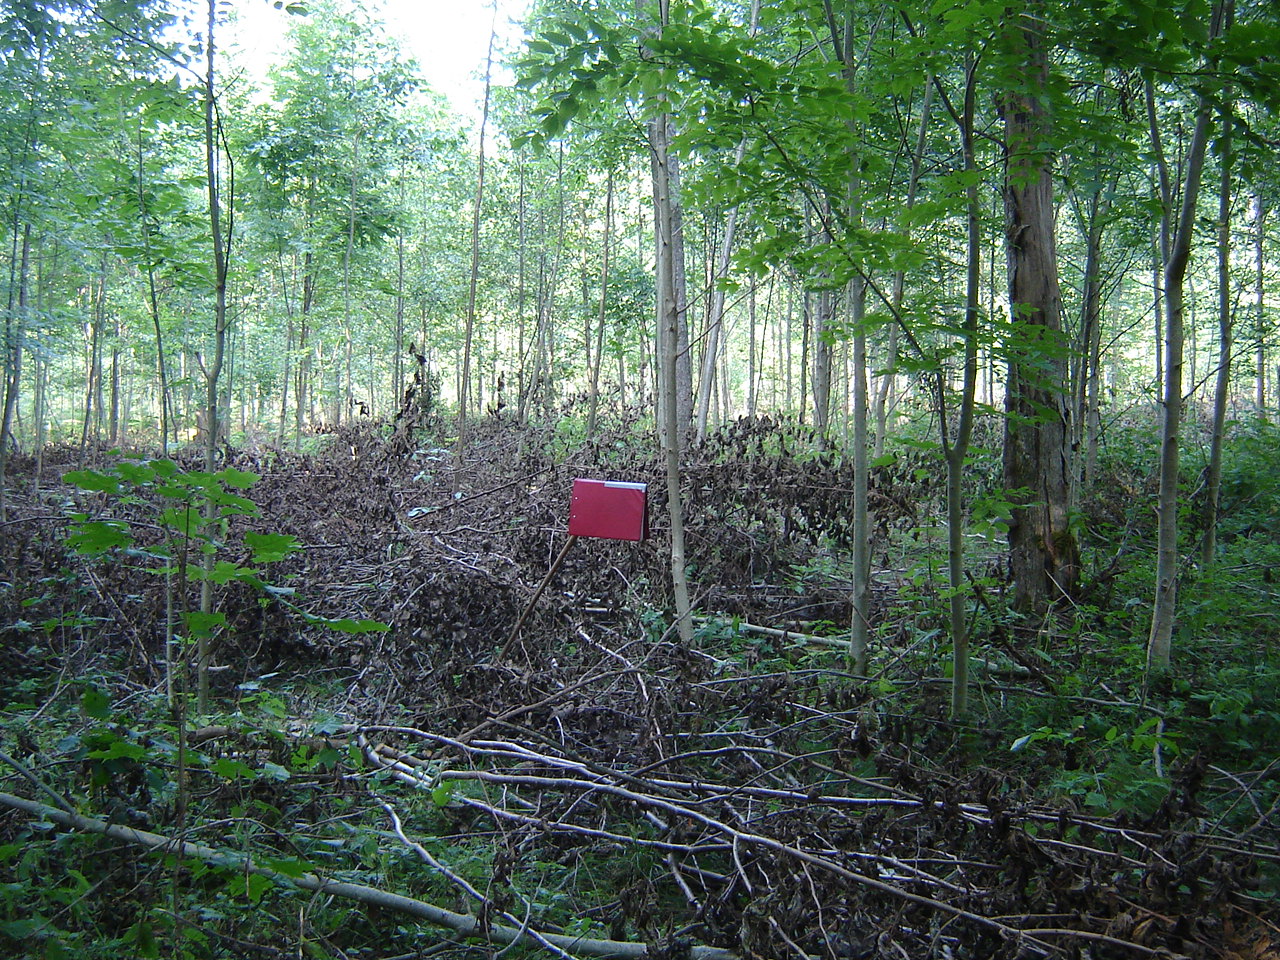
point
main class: Woodland
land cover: Broadleaved woodland
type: non-riverine alder, birch or aspen forest
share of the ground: > 75 %
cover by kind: broadleaved forest trees 80 %, unconsolidated bare surface 10 %, coniferous forest trees 5 %, herbaceous plants 5 %
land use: Forestry
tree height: > 5 m
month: August
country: LT
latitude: 55.1064
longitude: 24.9237
